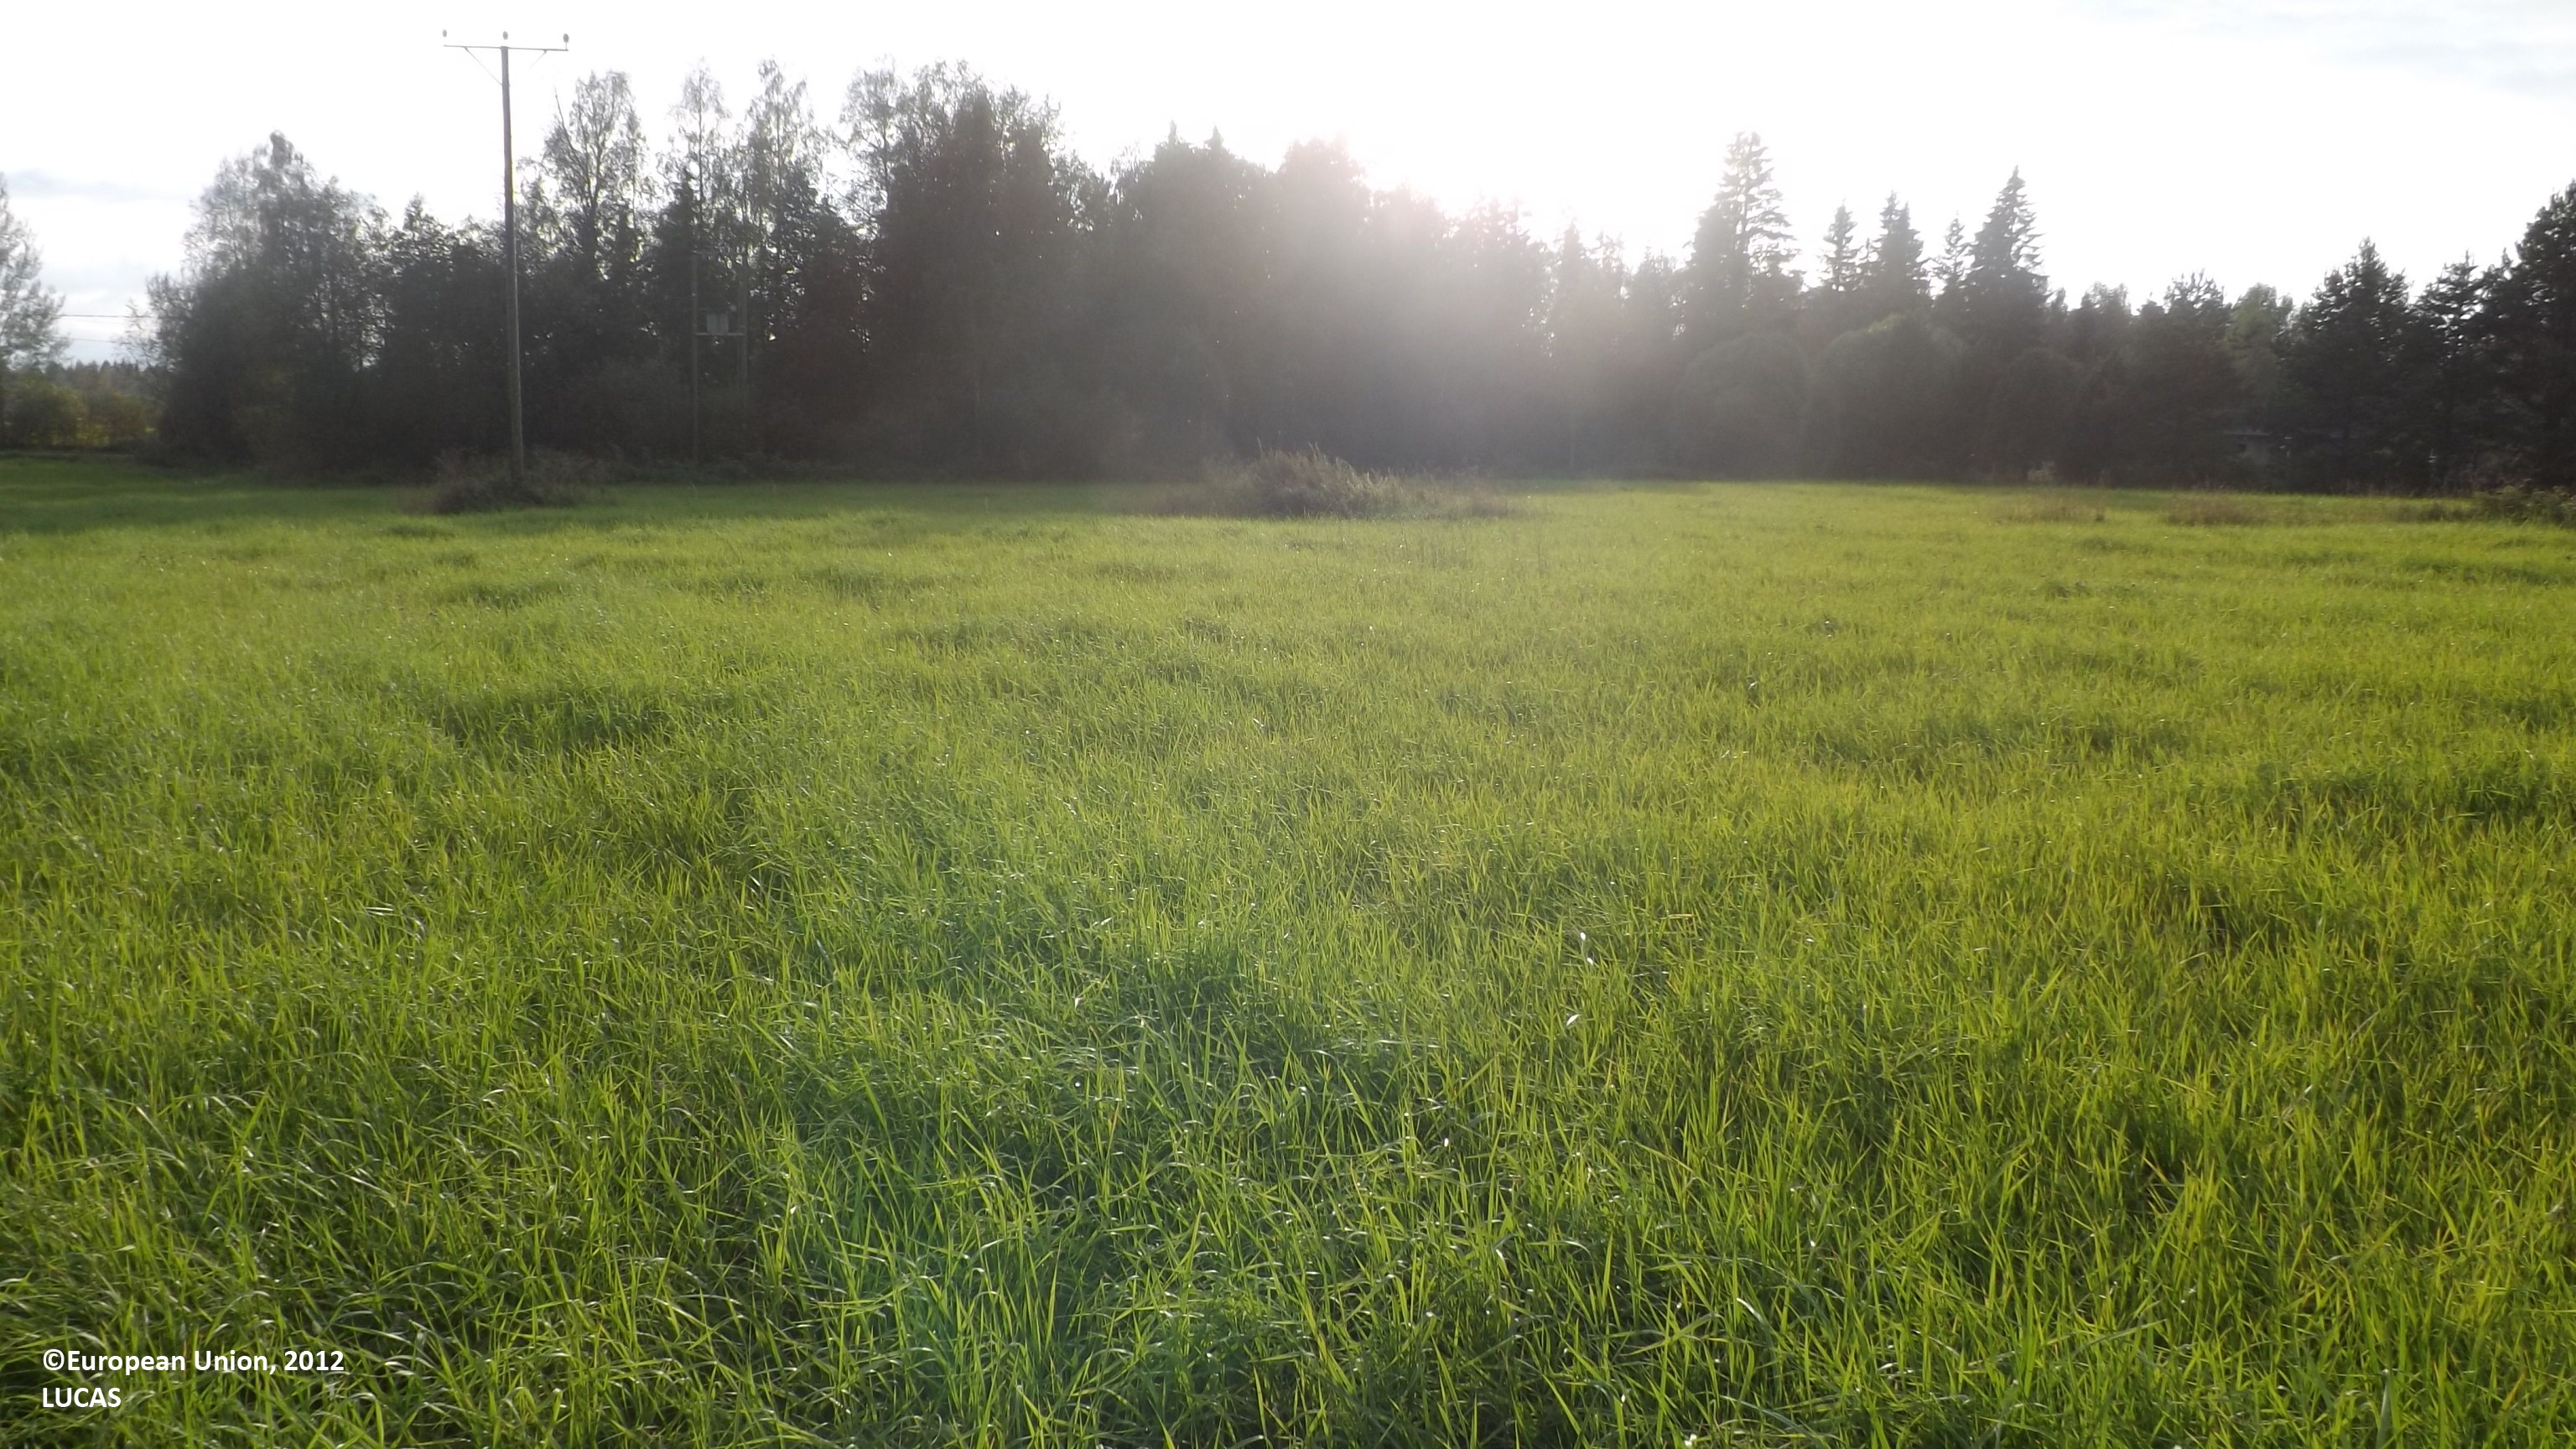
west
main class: Cropland
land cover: Temporary grasslands
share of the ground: > 75 %
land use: Agriculture (excluding fallow land and kitchen gardens)
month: August
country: FI
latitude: 63.8119
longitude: 23.3594
